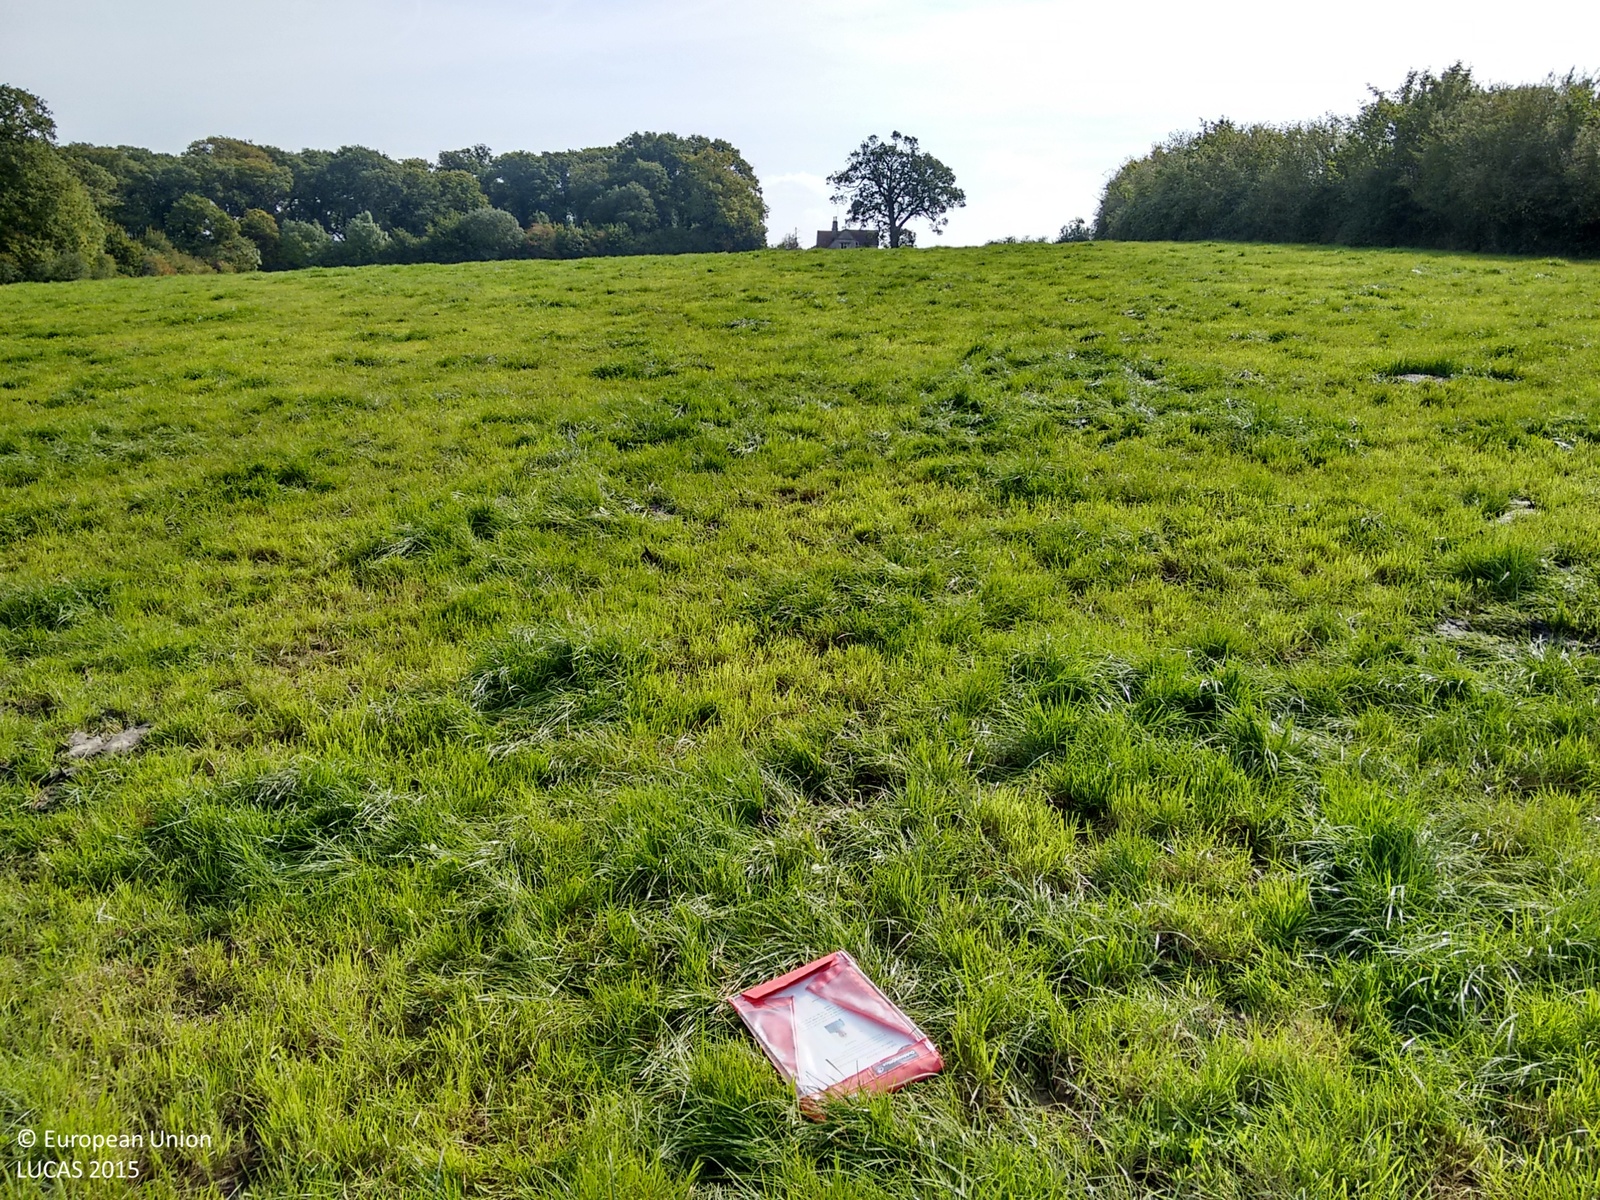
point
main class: Grassland
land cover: Grassland without tree/shrub cover
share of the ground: > 75 %
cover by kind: herbaceous plants 100 %
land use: Agriculture (excluding fallow land and kitchen gardens)
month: September
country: GB
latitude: 51.6313
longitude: -2.4174
